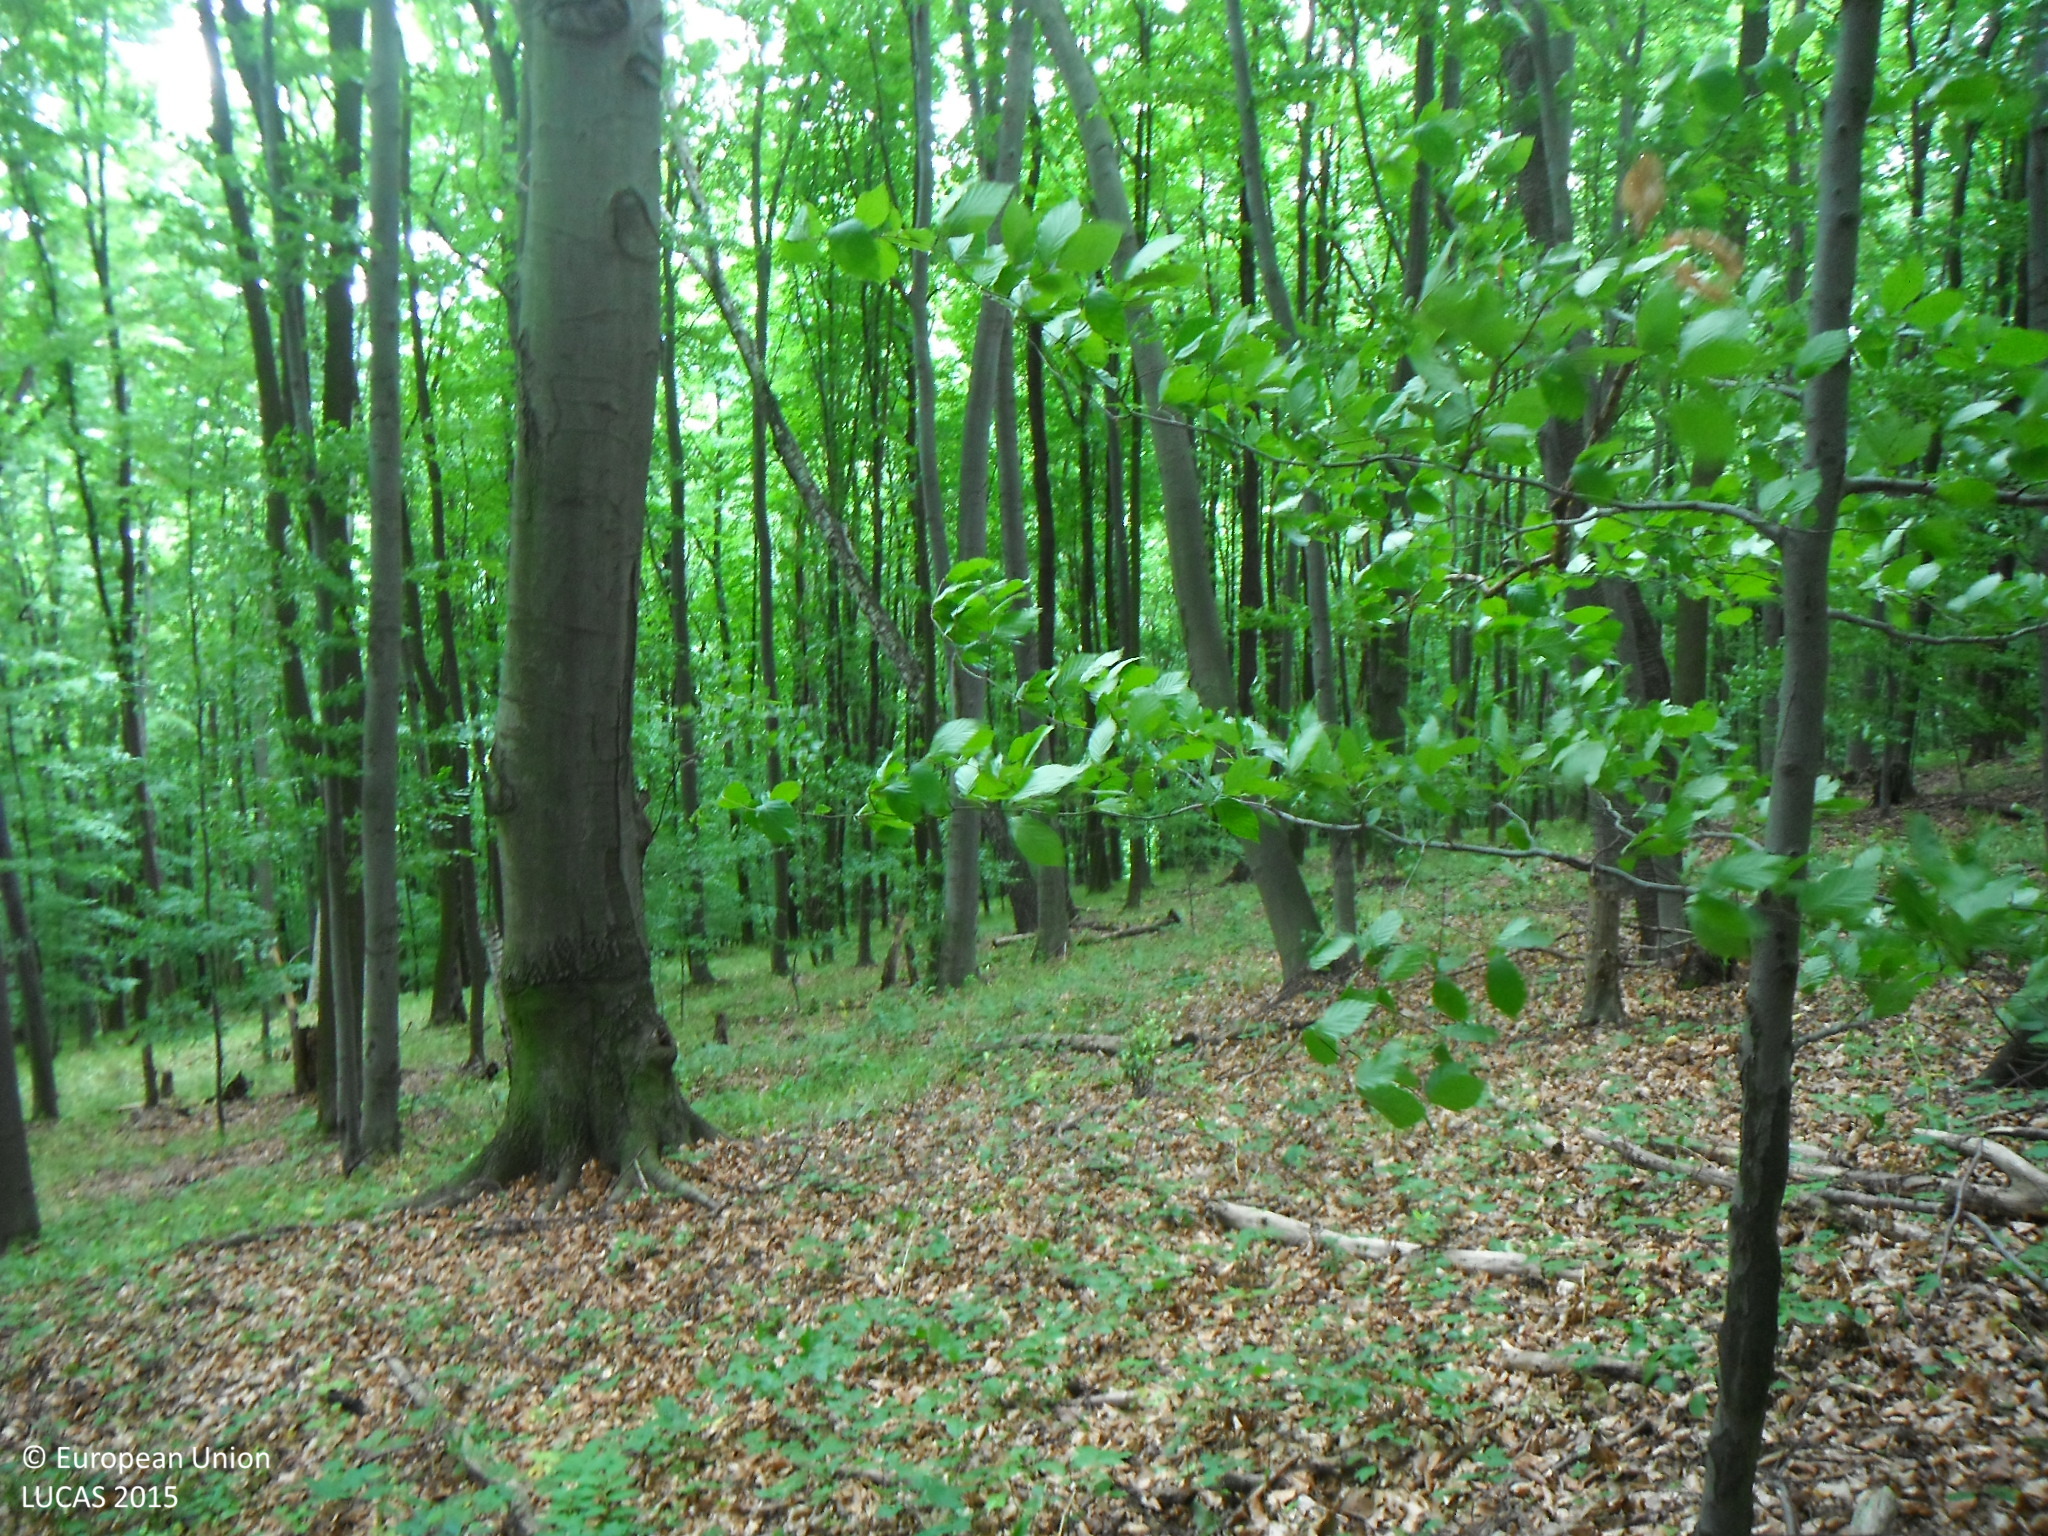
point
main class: Woodland
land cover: Broadleaved woodland
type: beech forest
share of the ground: > 75 %
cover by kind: broadleaved forest trees 100 %
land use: Forestry
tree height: > 5 m
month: June
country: SK
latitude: 49.1677
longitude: 21.6400
